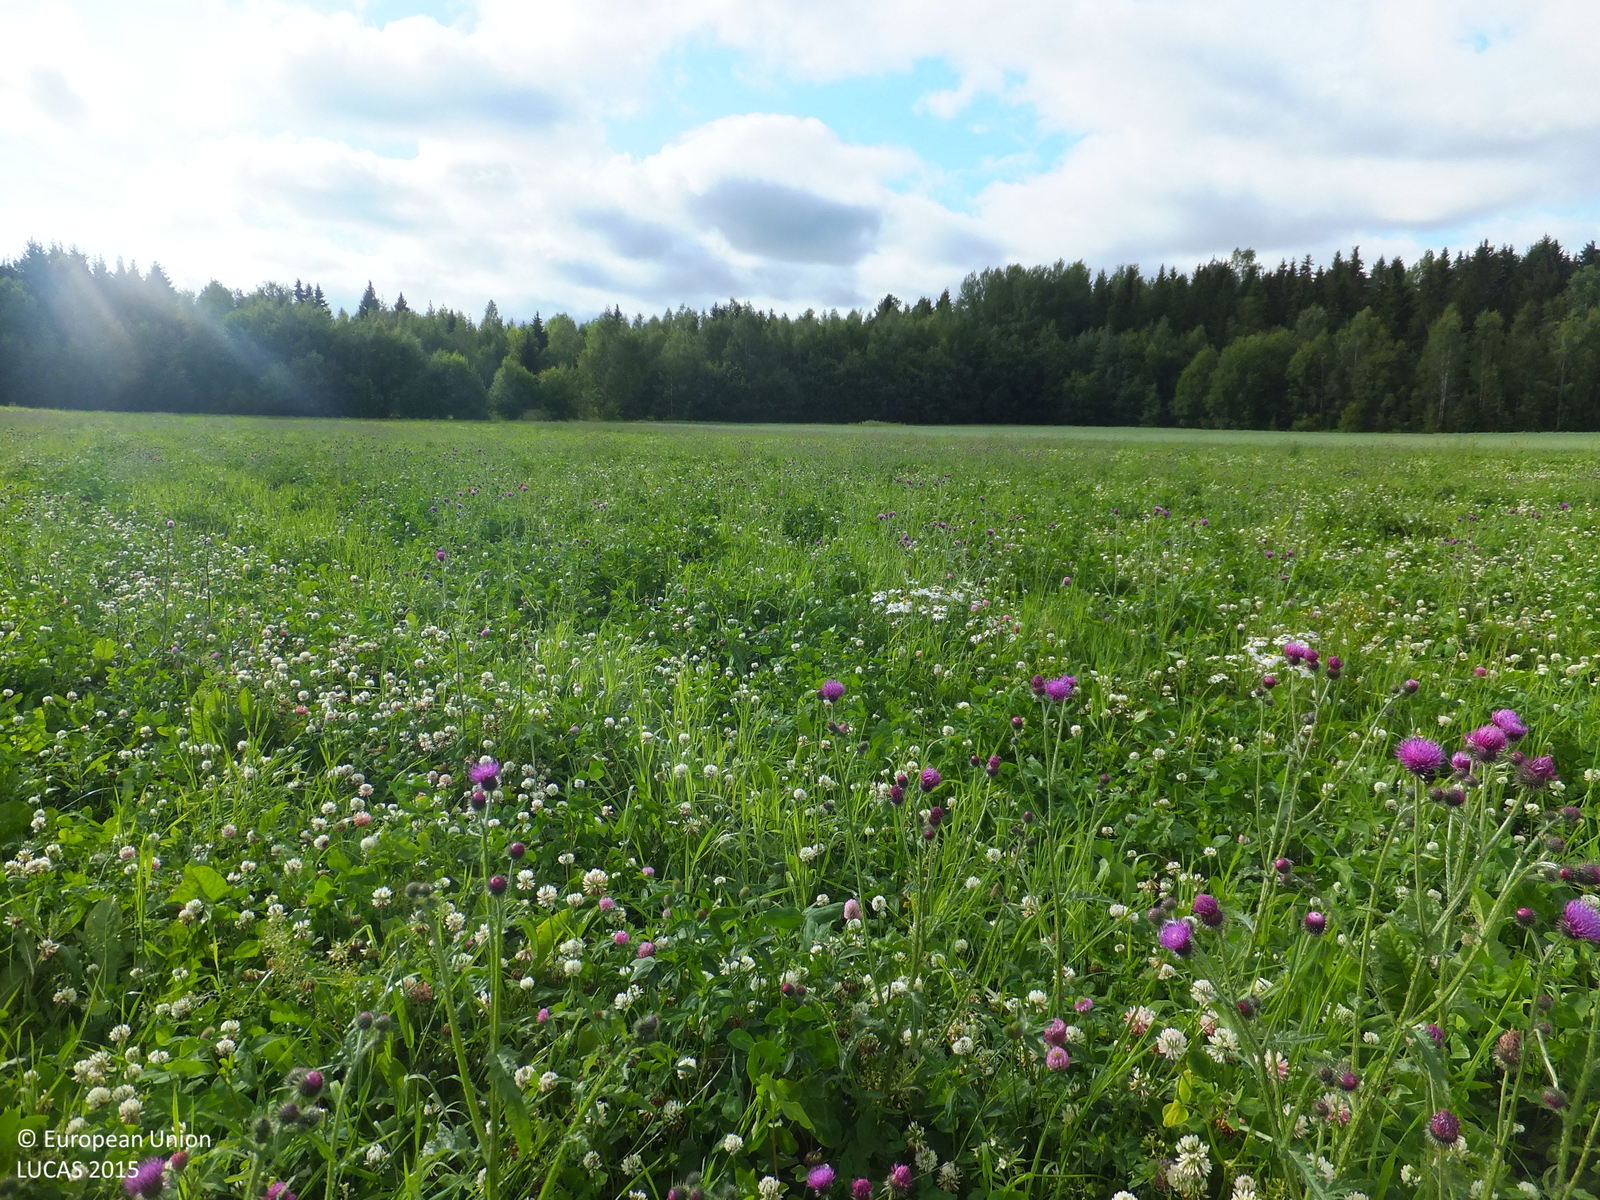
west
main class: Cropland
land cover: Clovers
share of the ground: > 75 %
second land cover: Temporary grasslands
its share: 50 - 75 %
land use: Agriculture (excluding fallow land and kitchen gardens)
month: July
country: FI
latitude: 63.1942
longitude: 22.1900
